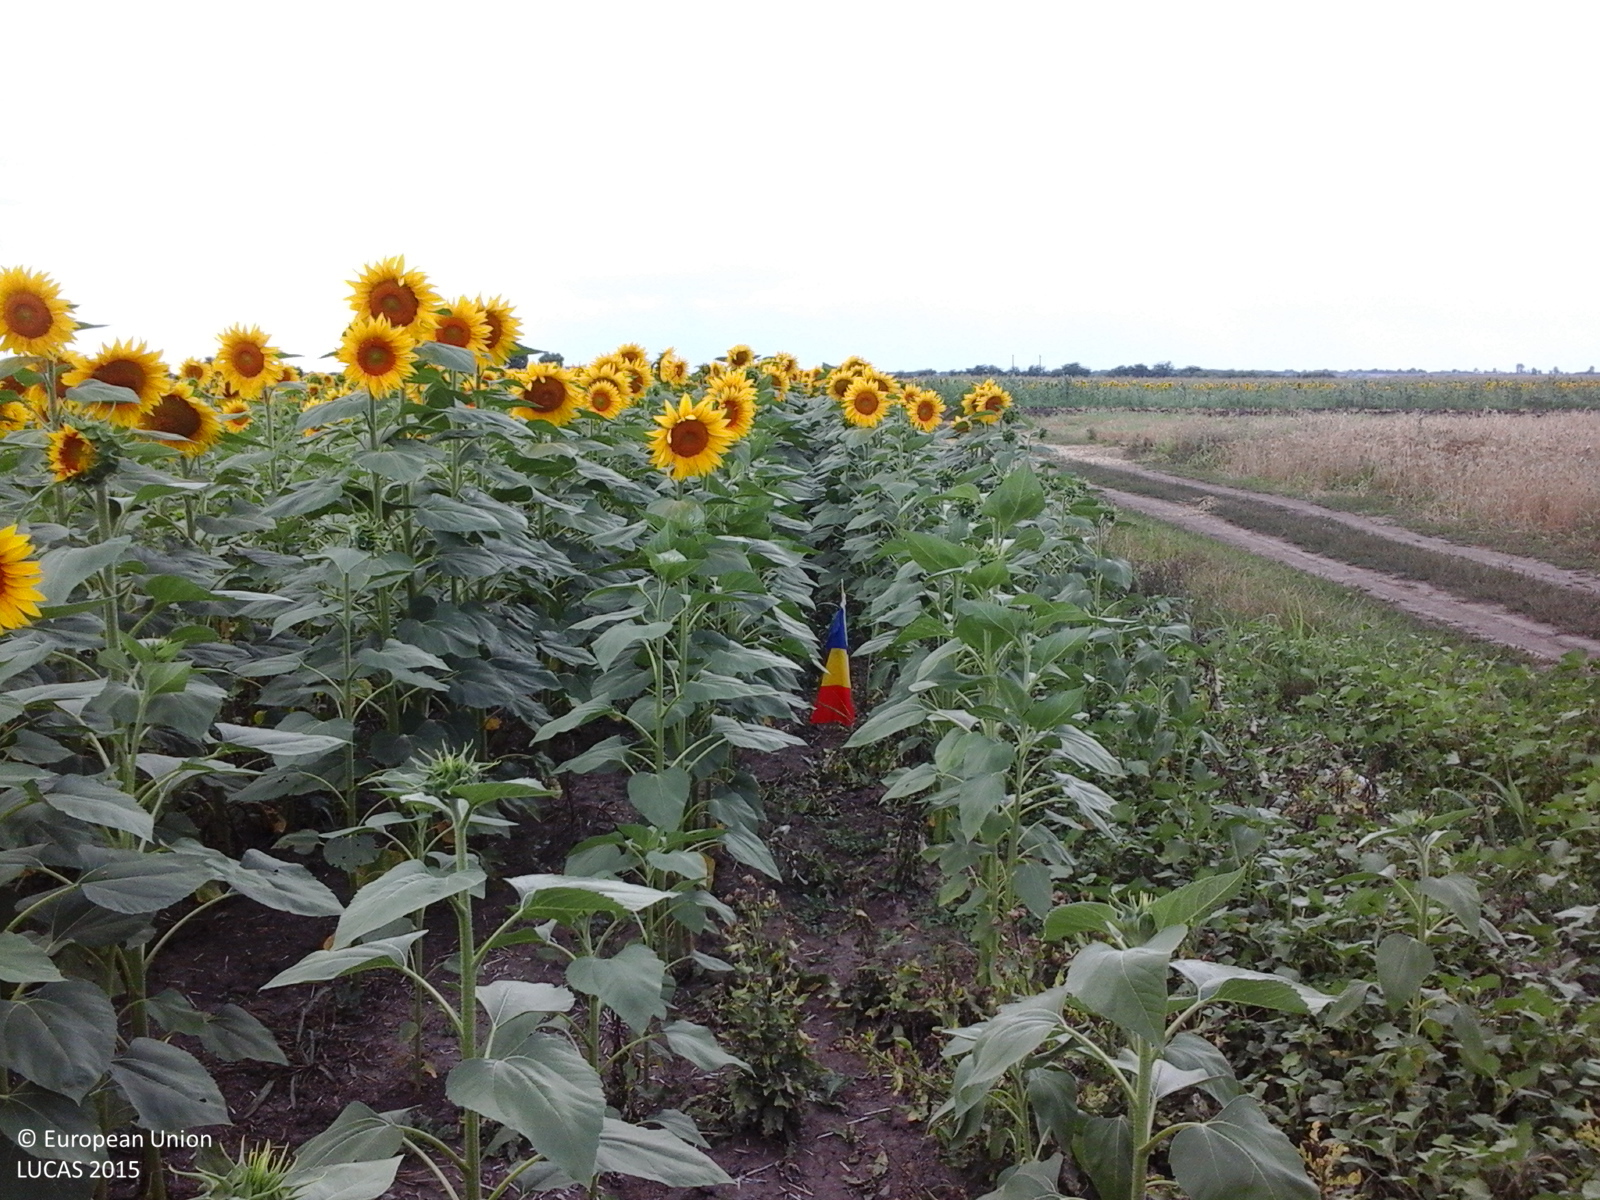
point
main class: Cropland
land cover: Sunflower
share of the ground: > 75 %
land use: Agriculture (excluding fallow land and kitchen gardens)
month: July
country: RO
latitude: 43.9010
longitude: 24.4445
